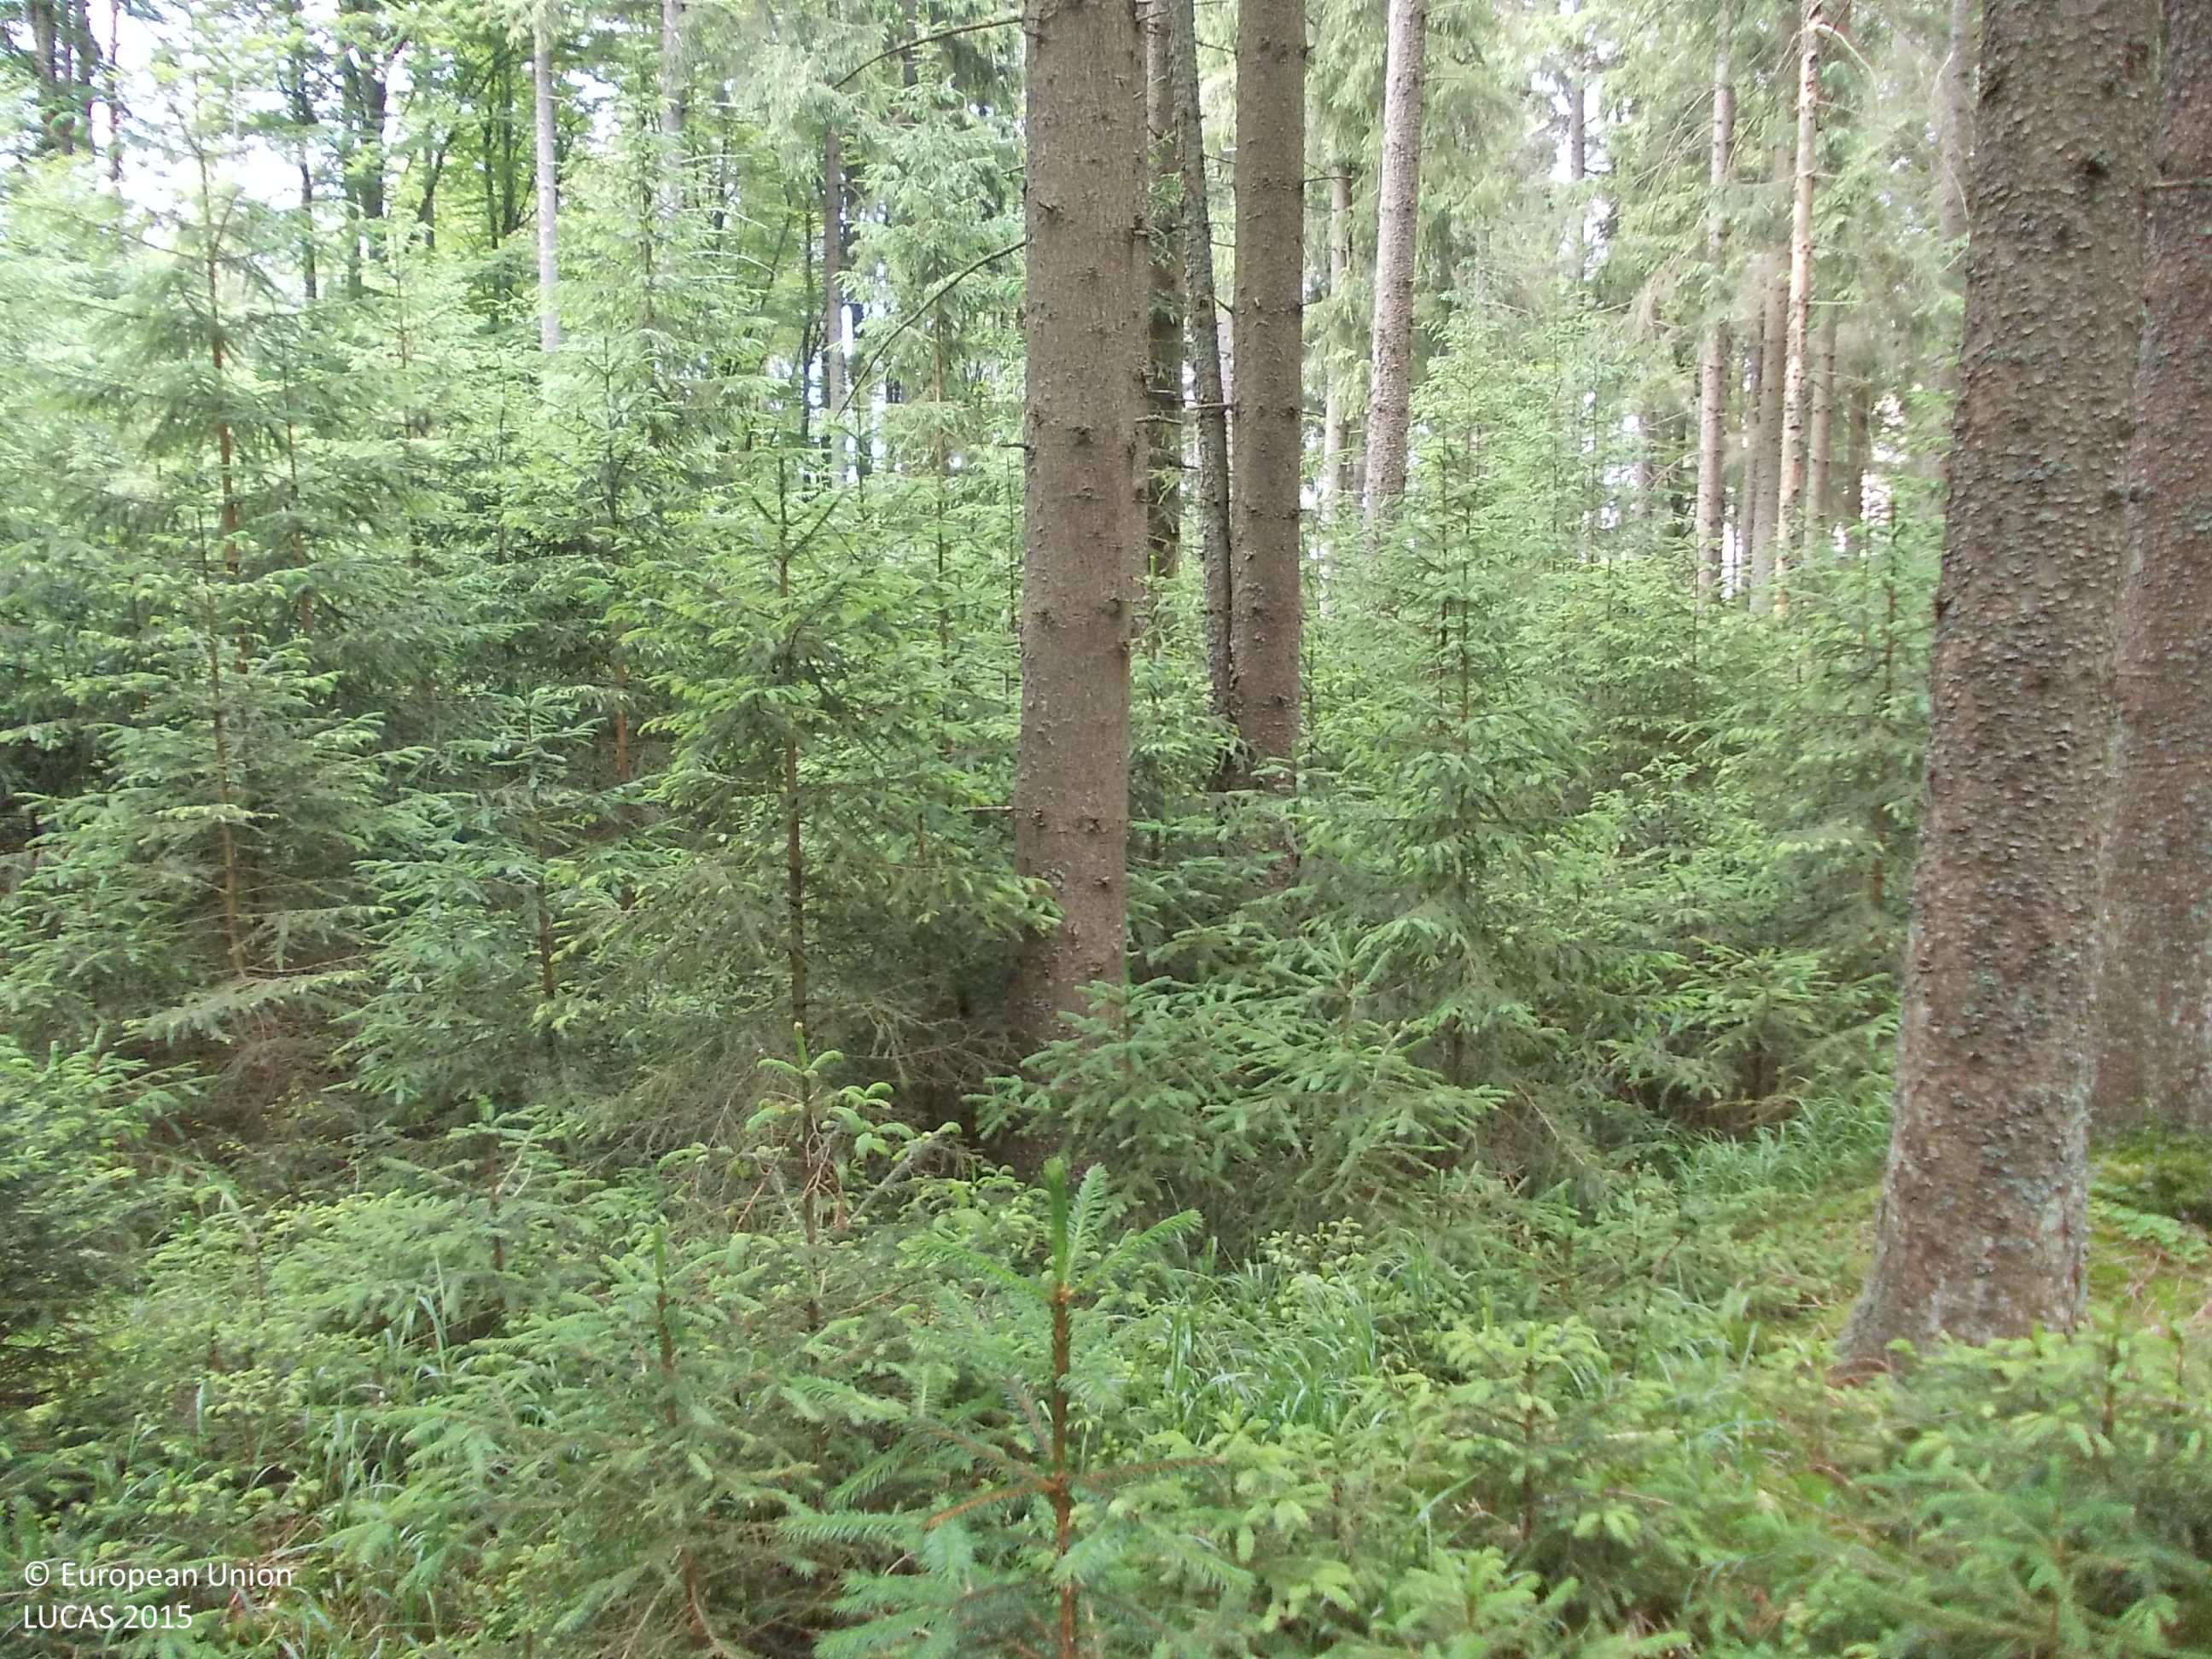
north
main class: Woodland
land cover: Spruce dominated coniferous woodland
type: hemiboreal forest and nemoral coniferous forest and mixed broadleaved-coniferous forest
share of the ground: > 75 %
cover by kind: coniferous forest trees 80 %, herbaceous plants 15 %, unconsolidated bare surface 5 %
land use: Forestry
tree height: > 5 m
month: June
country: CZ
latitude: 48.8227
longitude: 13.8547
